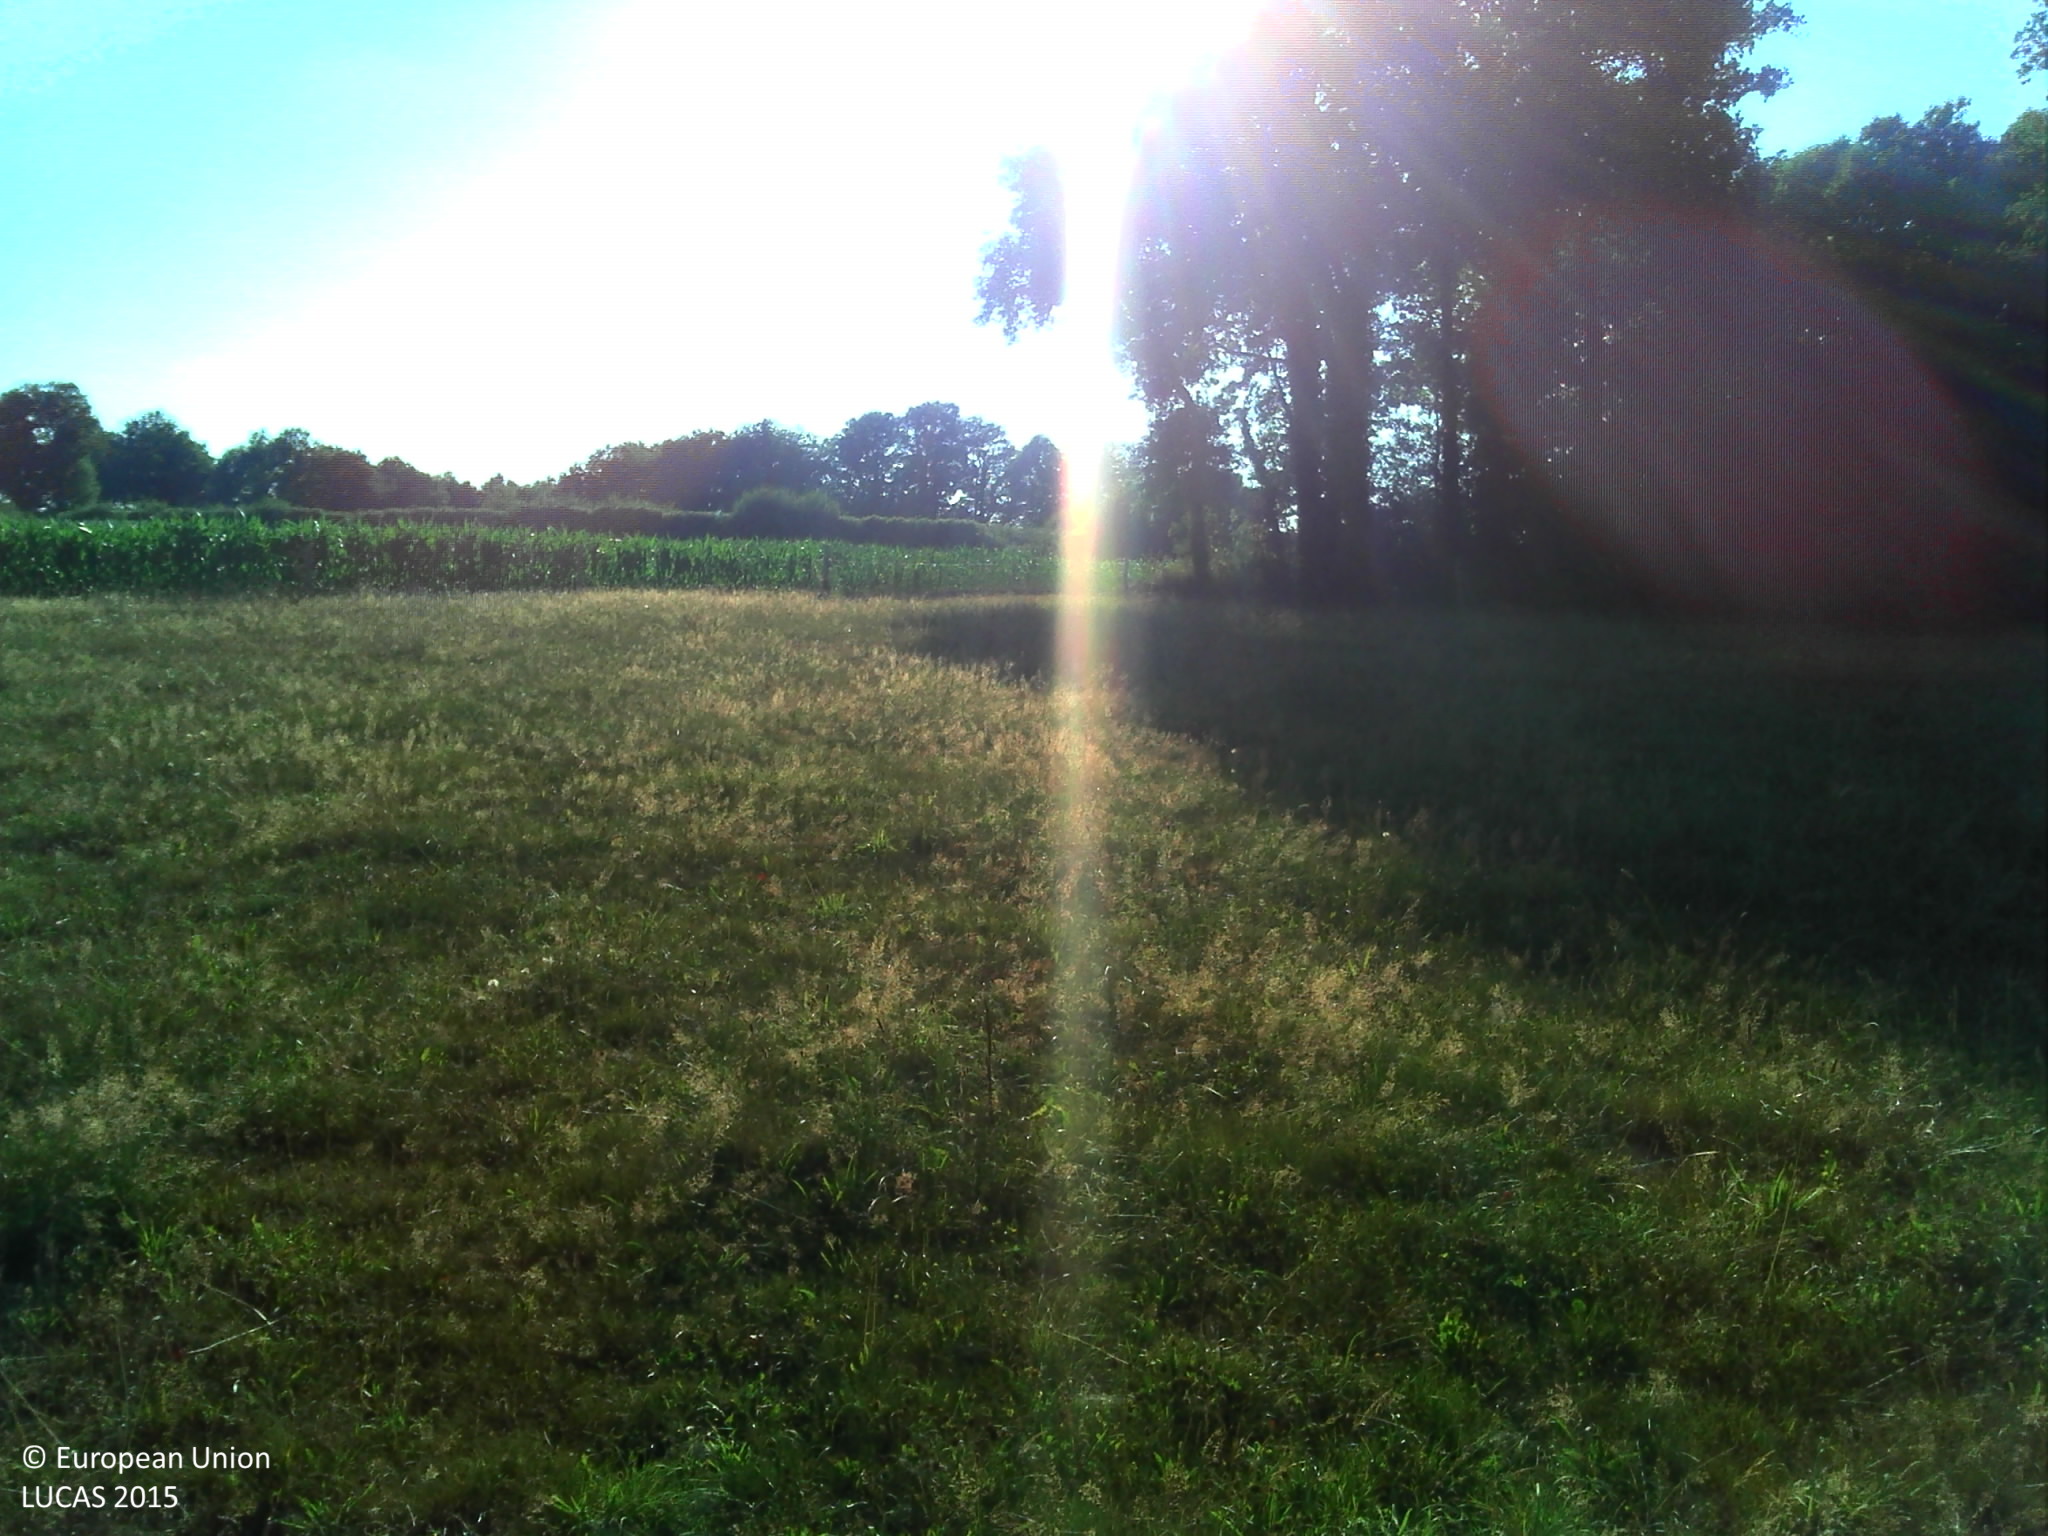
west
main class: Grassland
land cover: Grassland without tree/shrub cover
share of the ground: > 75 %
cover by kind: herbaceous plants 100 %
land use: Agriculture (excluding fallow land and kitchen gardens)
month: July
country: FR
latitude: 46.2397
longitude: 1.6267
